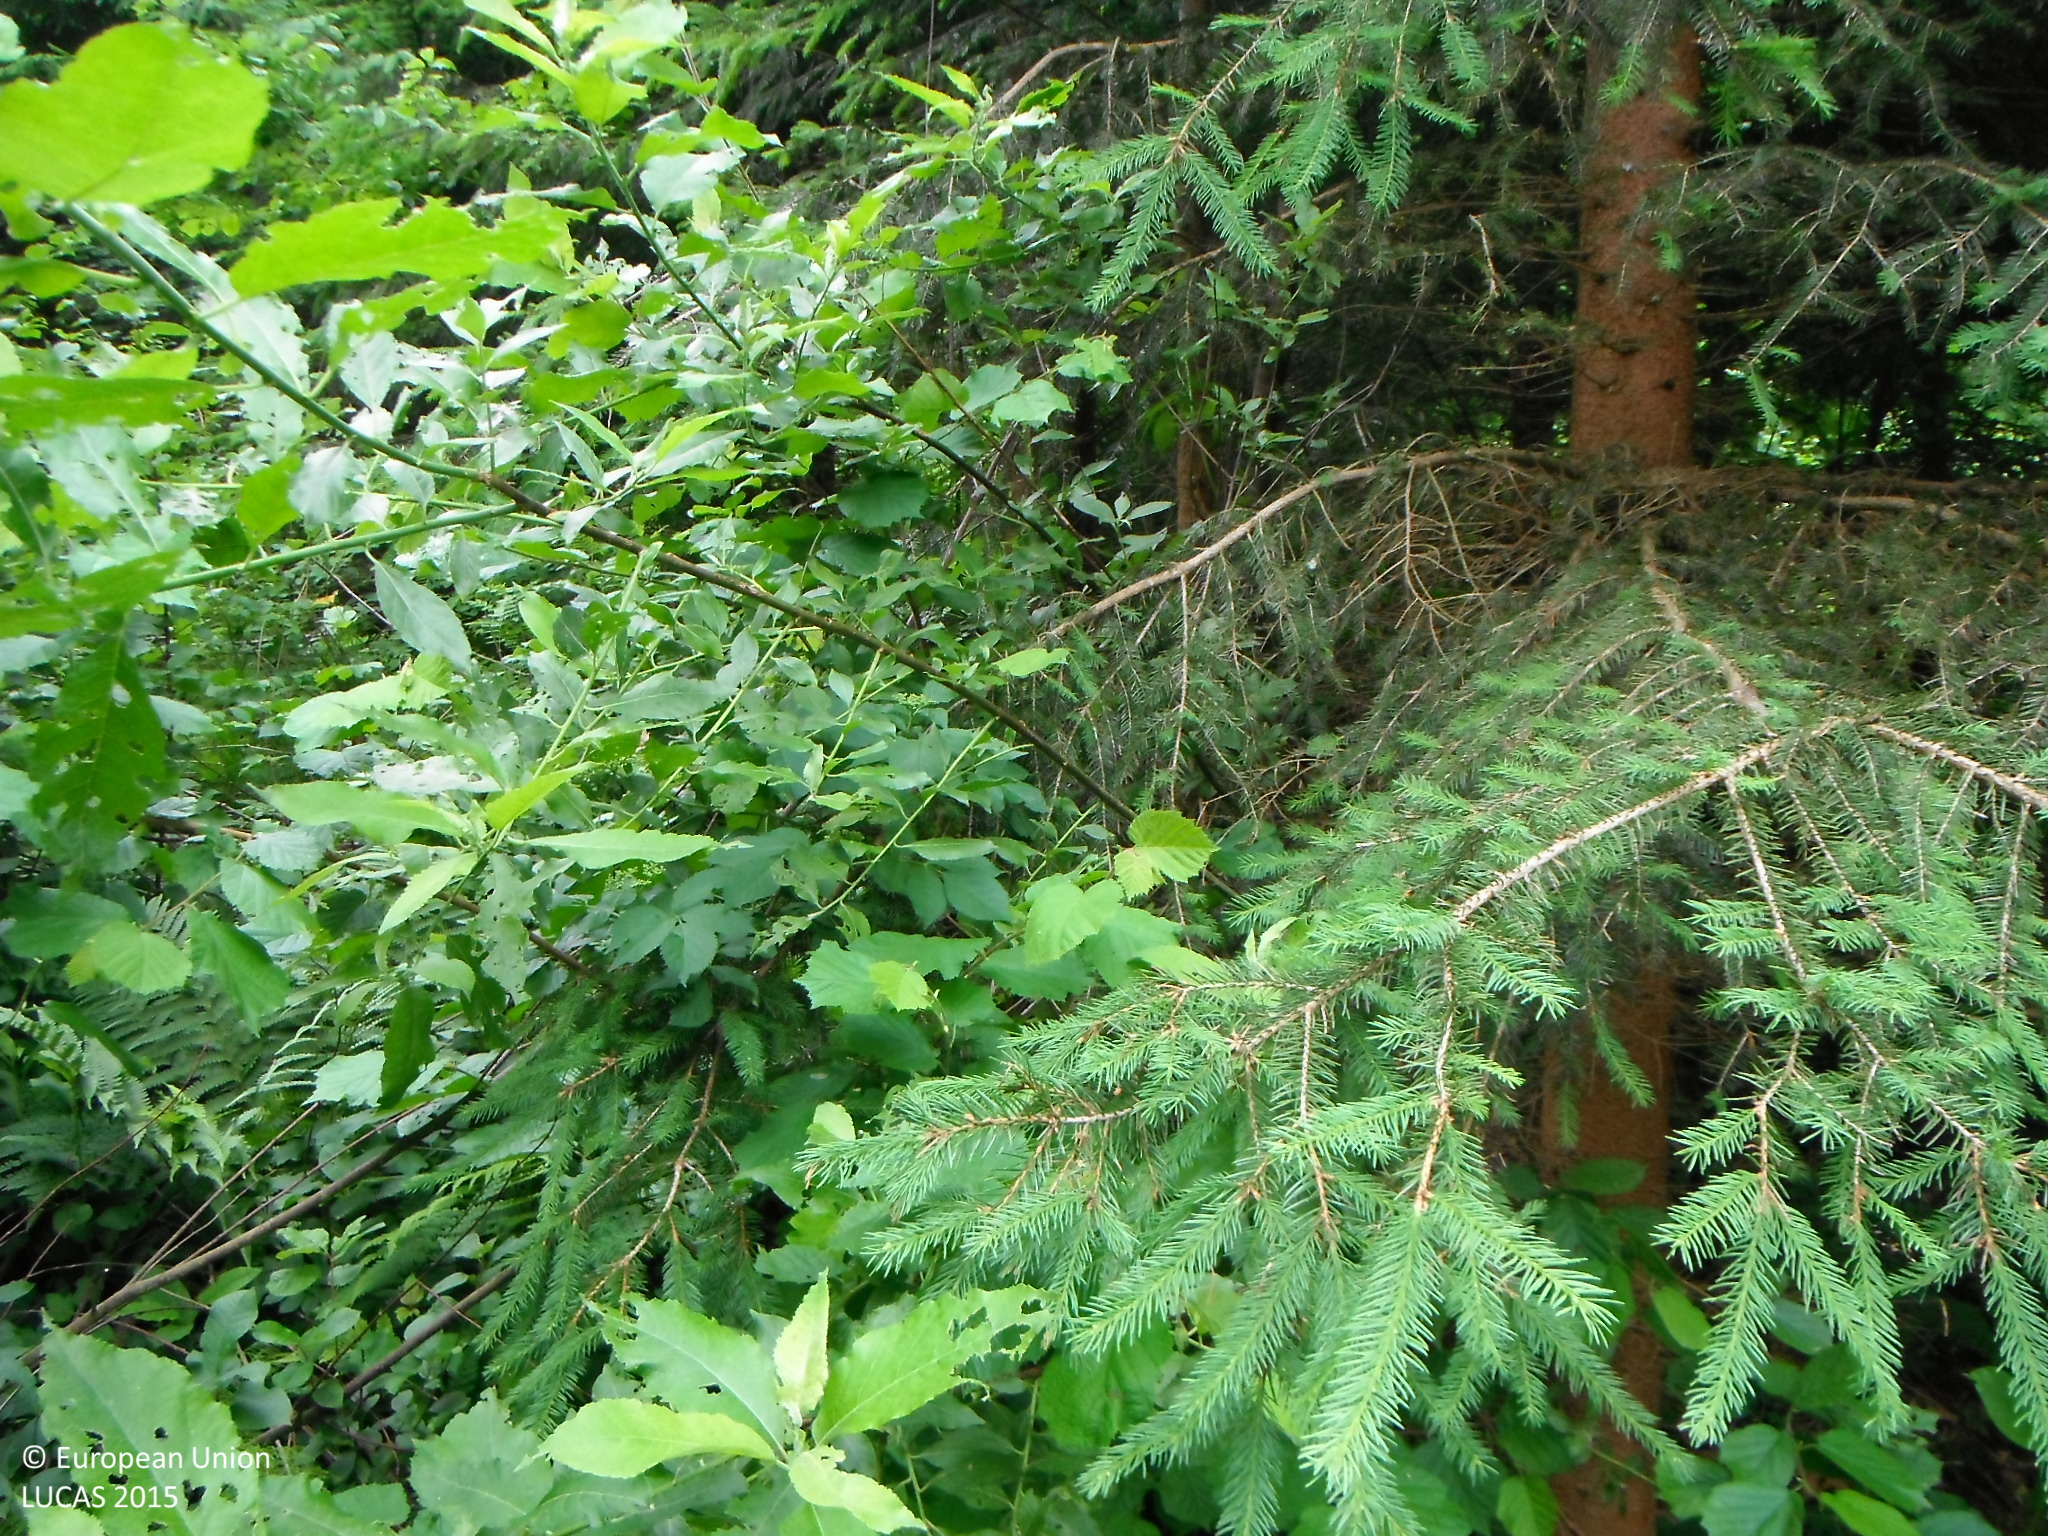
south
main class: Woodland
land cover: Spruce dominated coniferous woodland
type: hemiboreal forest and nemoral coniferous forest and mixed broadleaved-coniferous forest
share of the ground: 50 - 75 %
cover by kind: coniferous forest trees 65 %, shrubs 15 %, herbaceous plants 15 %, broadleaved forest trees 5 %
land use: Forestry
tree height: > 5 m
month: June
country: SK
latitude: 49.2000
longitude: 19.3712
